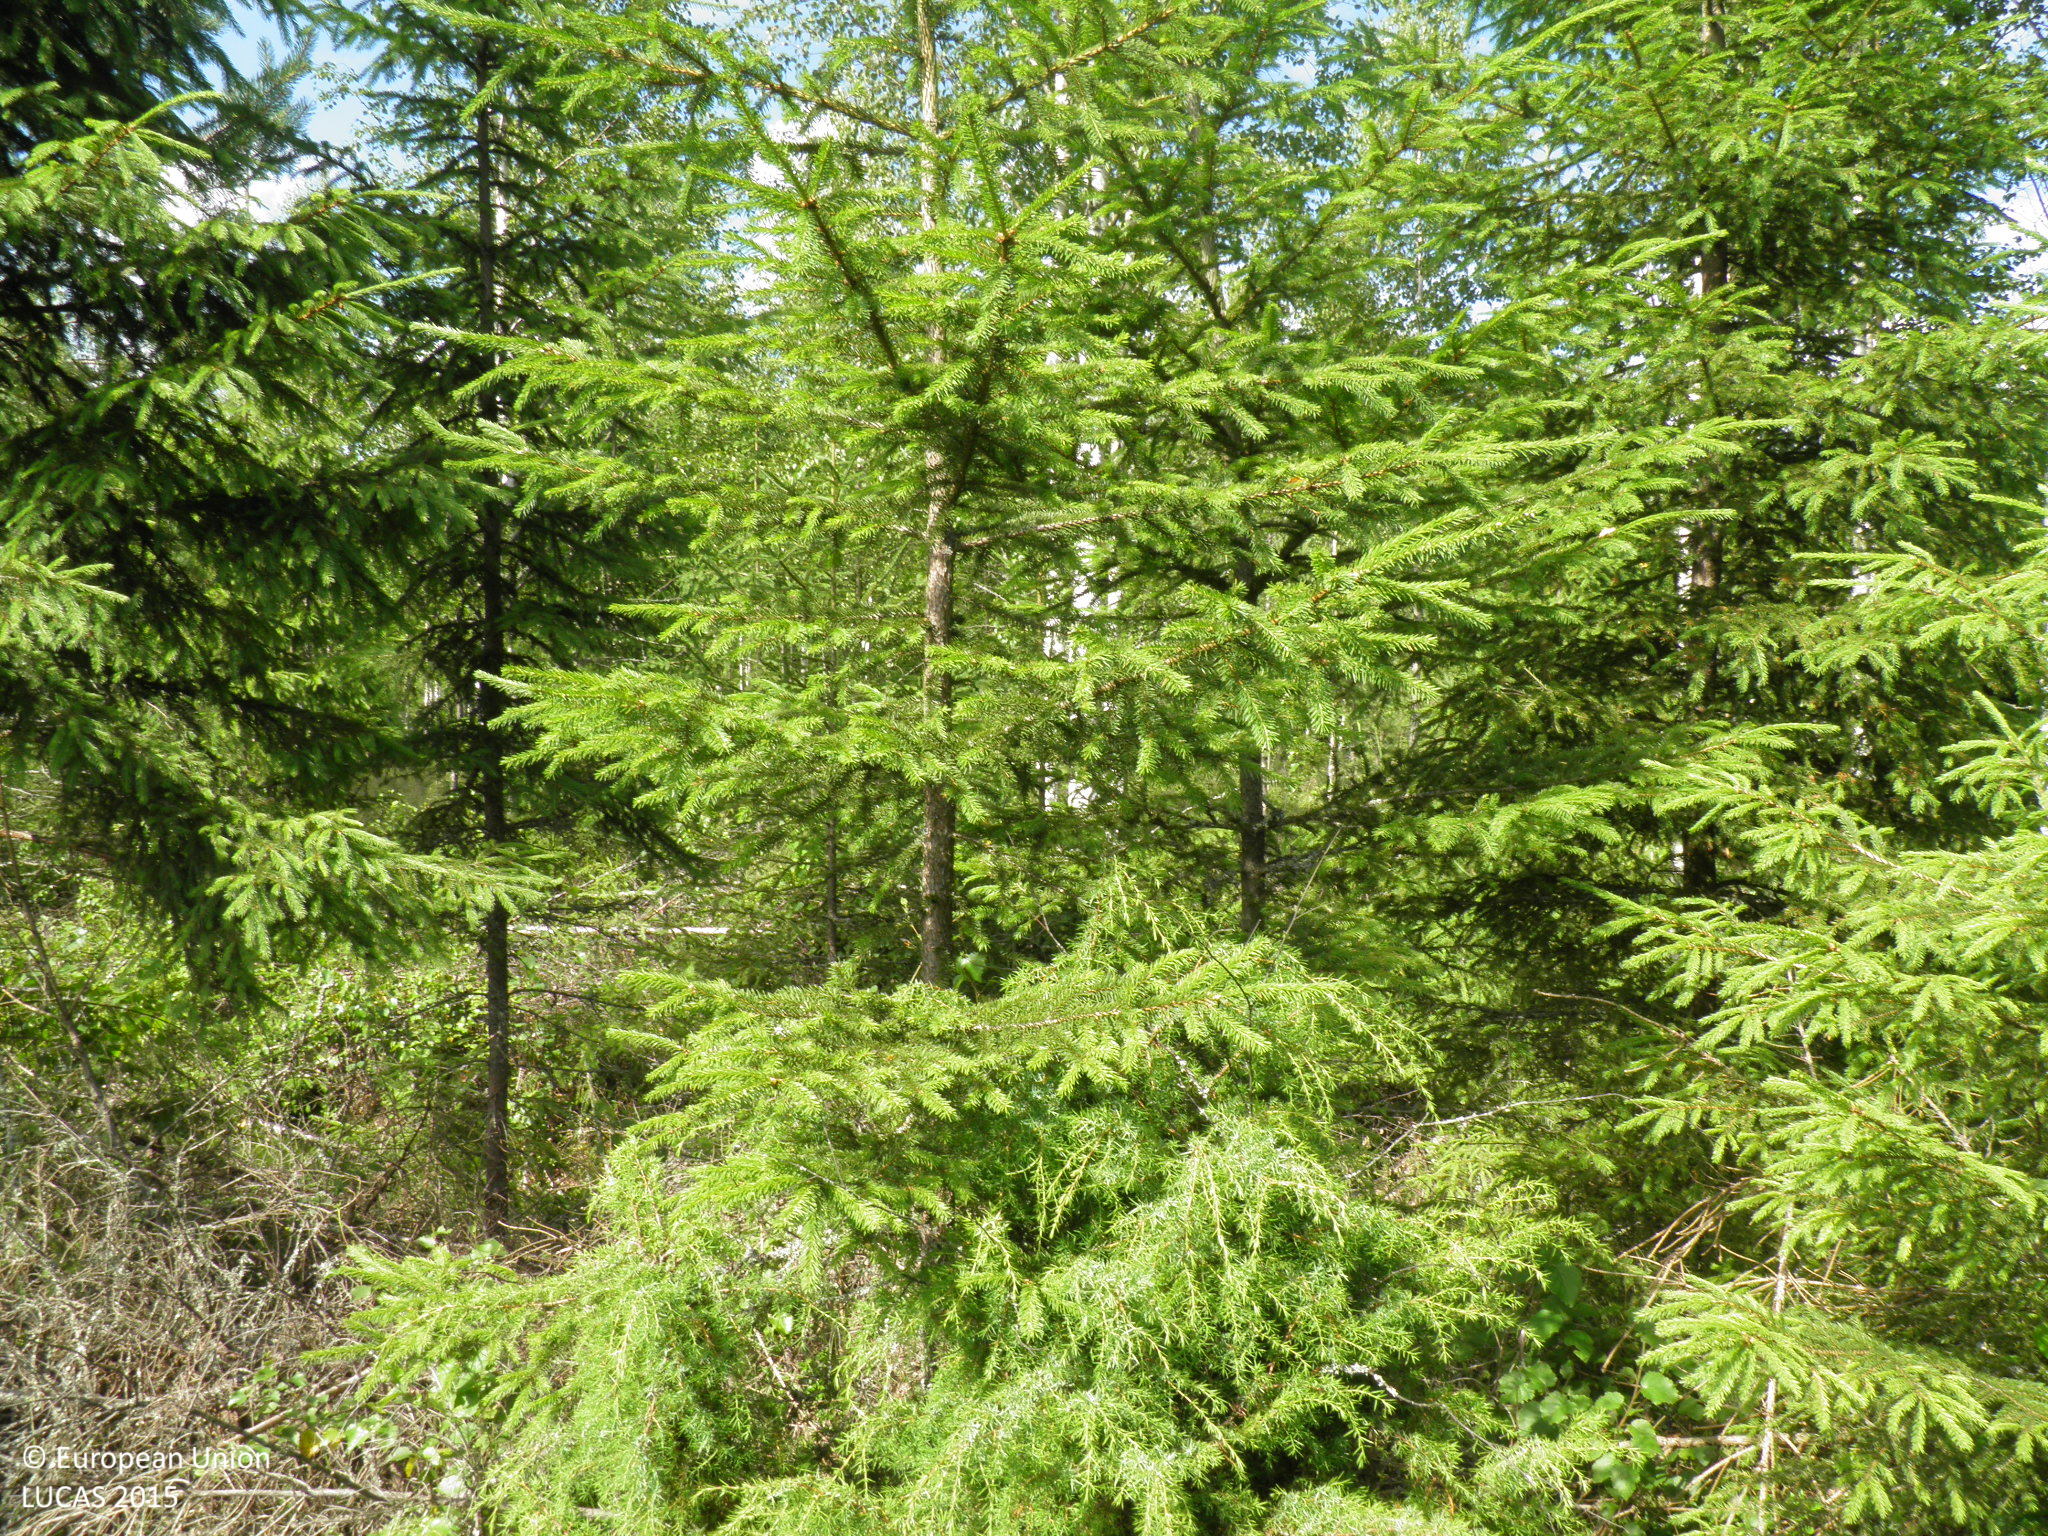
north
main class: Woodland
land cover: Spruce dominated mixed woodland
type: hemiboreal forest and nemoral coniferous forest and mixed broadleaved-coniferous forest
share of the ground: 25 - 50 %
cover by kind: shrubs 55 %, coniferous forest trees 20 %, broadleaved forest trees 20 %, herbaceous plants 5 %
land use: Forestry
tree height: > 5 m
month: July
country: FI
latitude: 60.7568
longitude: 22.6782
